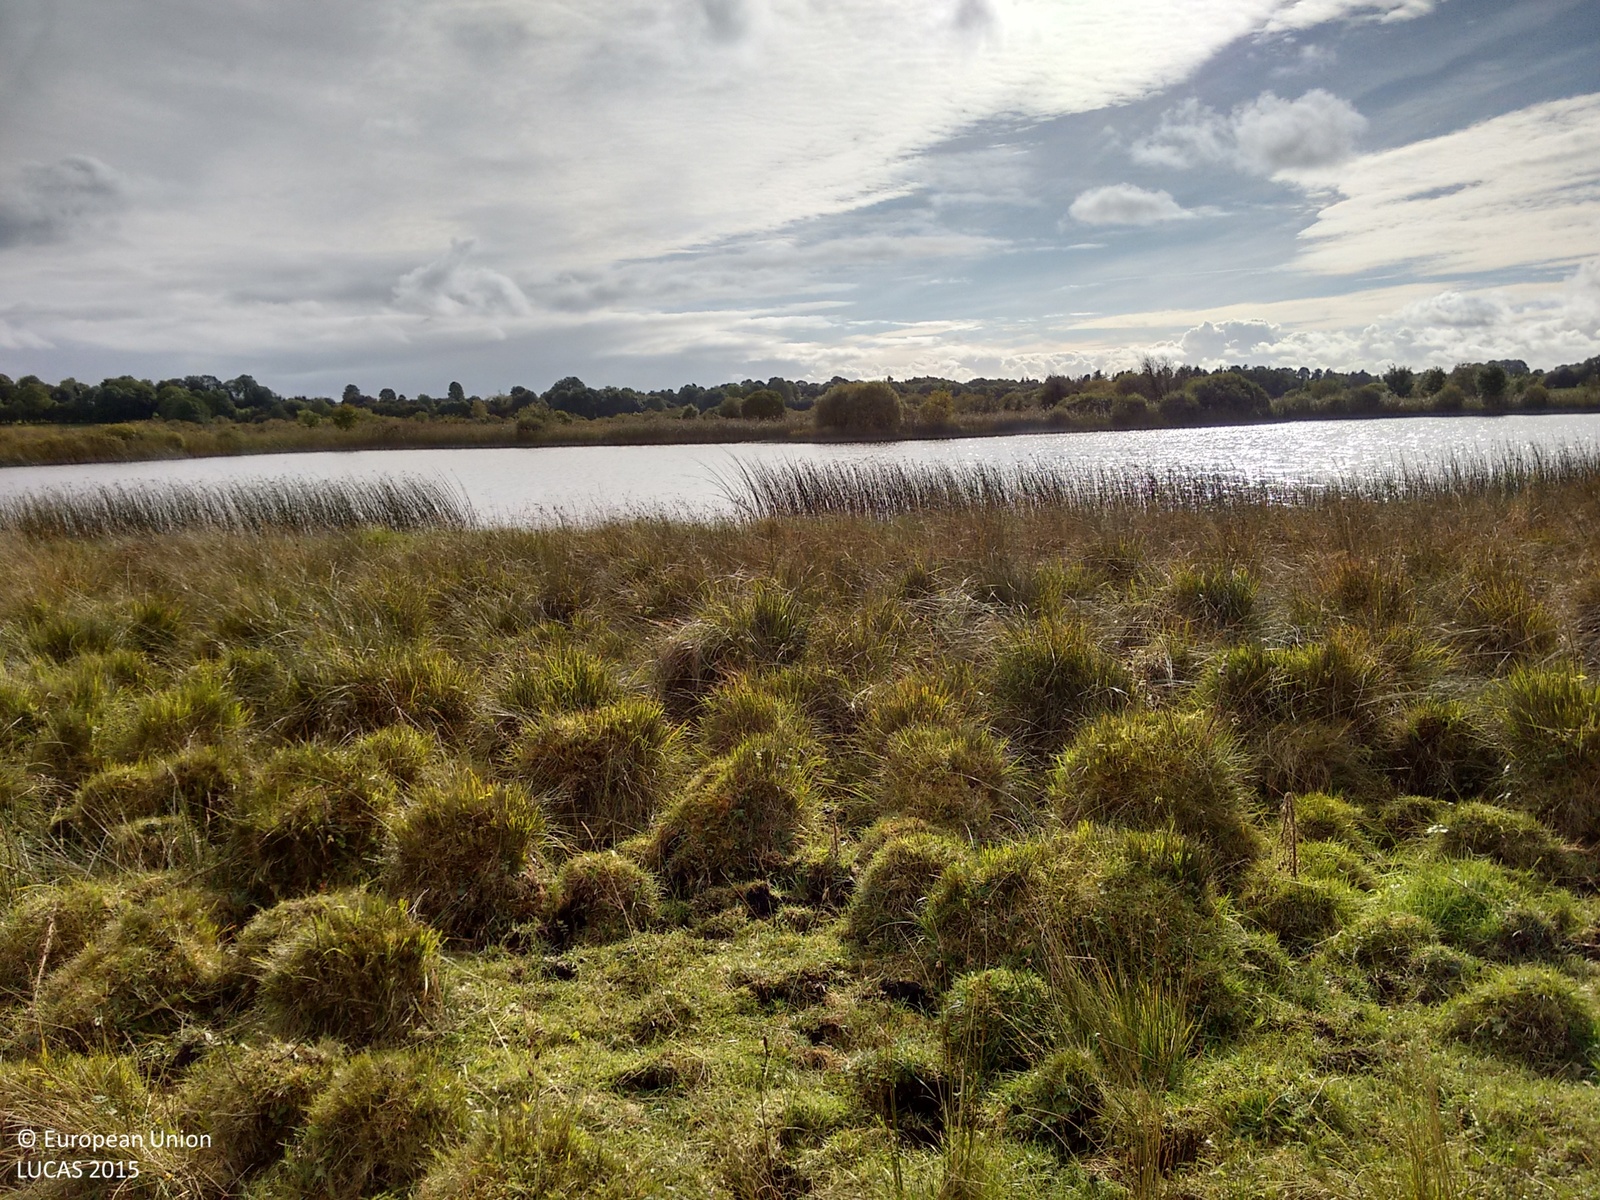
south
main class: Grassland
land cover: Grassland without tree/shrub cover
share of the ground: > 75 %
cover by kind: herbaceous plants 100 %
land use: Agriculture (excluding fallow land and kitchen gardens)
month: October
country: IE
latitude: 53.8179
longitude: -8.1805
